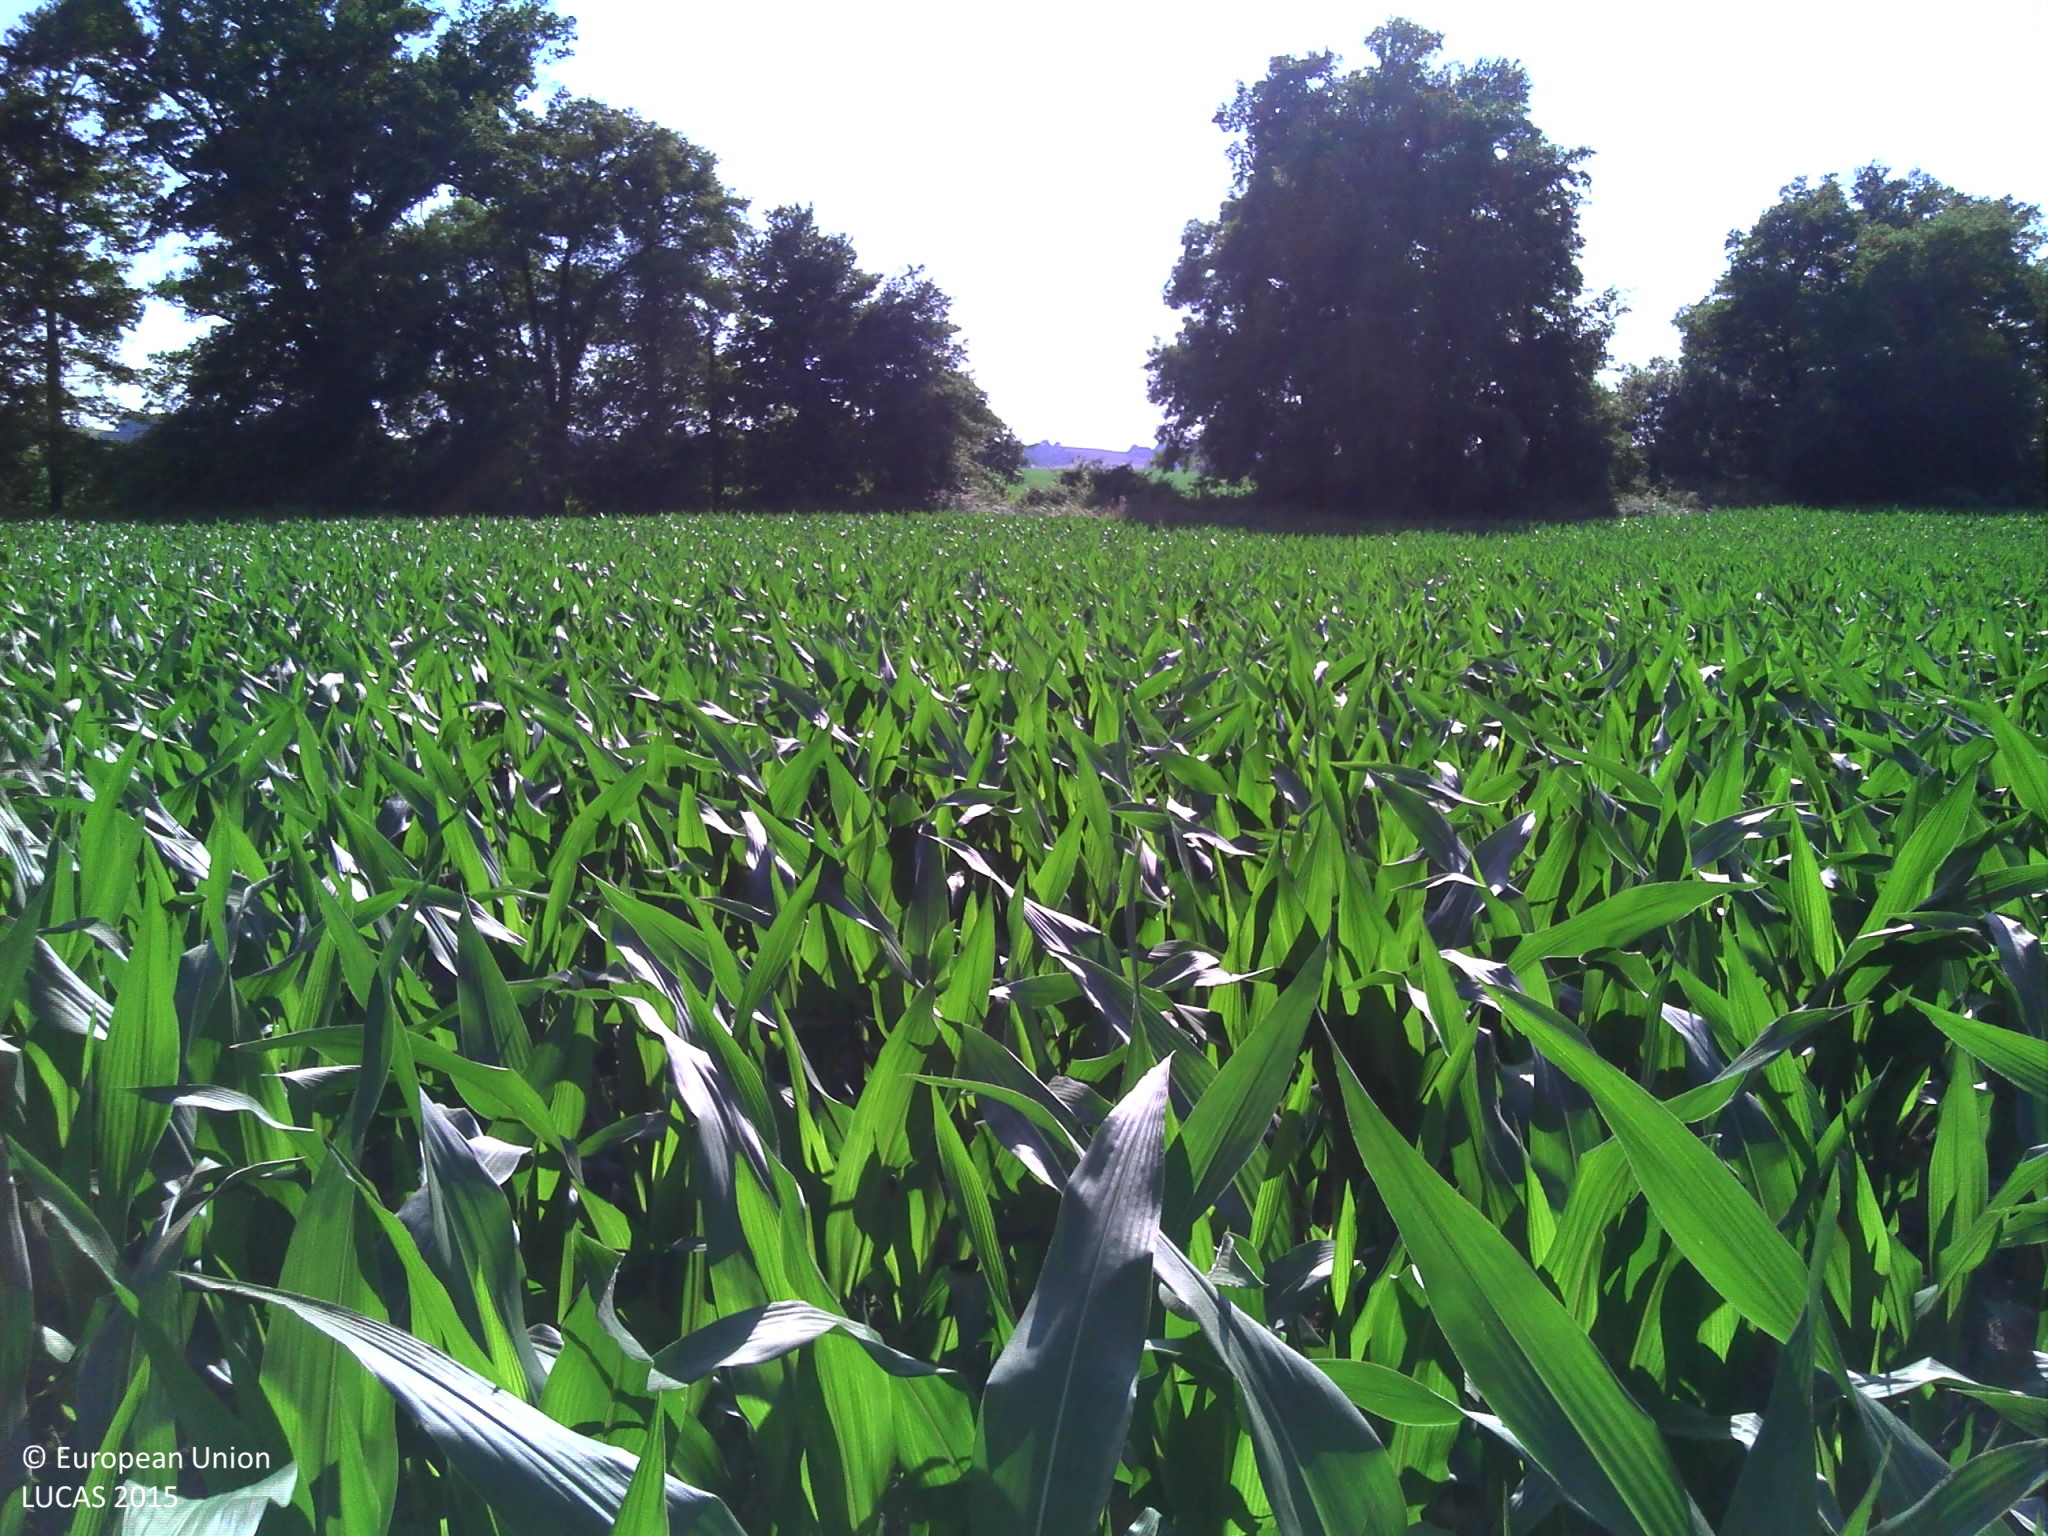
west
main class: Cropland
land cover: Maize
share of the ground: > 75 %
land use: Agriculture (excluding fallow land and kitchen gardens)
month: June
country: FR
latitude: 43.6031
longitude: -0.4531
